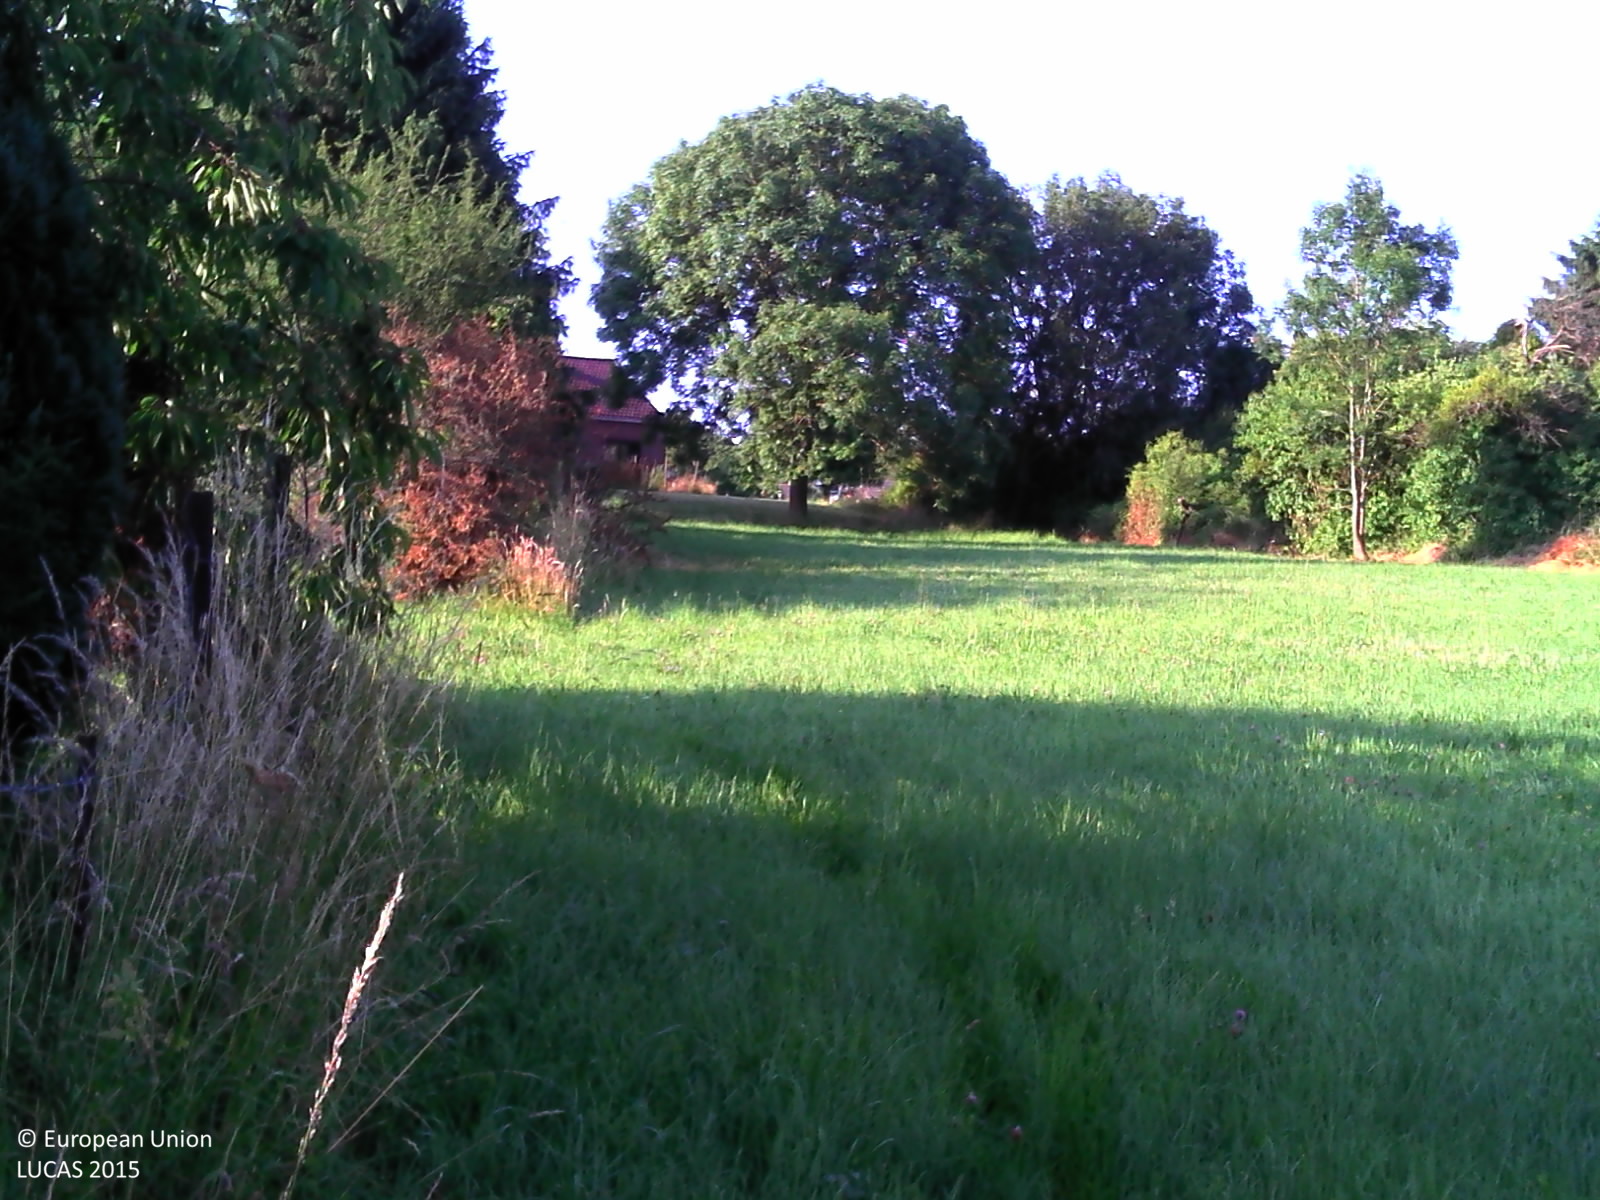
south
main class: Grassland
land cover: Grassland with sparse tree/shrub cover
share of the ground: > 75 %
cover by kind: herbaceous plants 95 %, broadleaved forest trees 5 %
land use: Residential
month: July
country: BE
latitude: 50.3365
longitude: 4.8124
